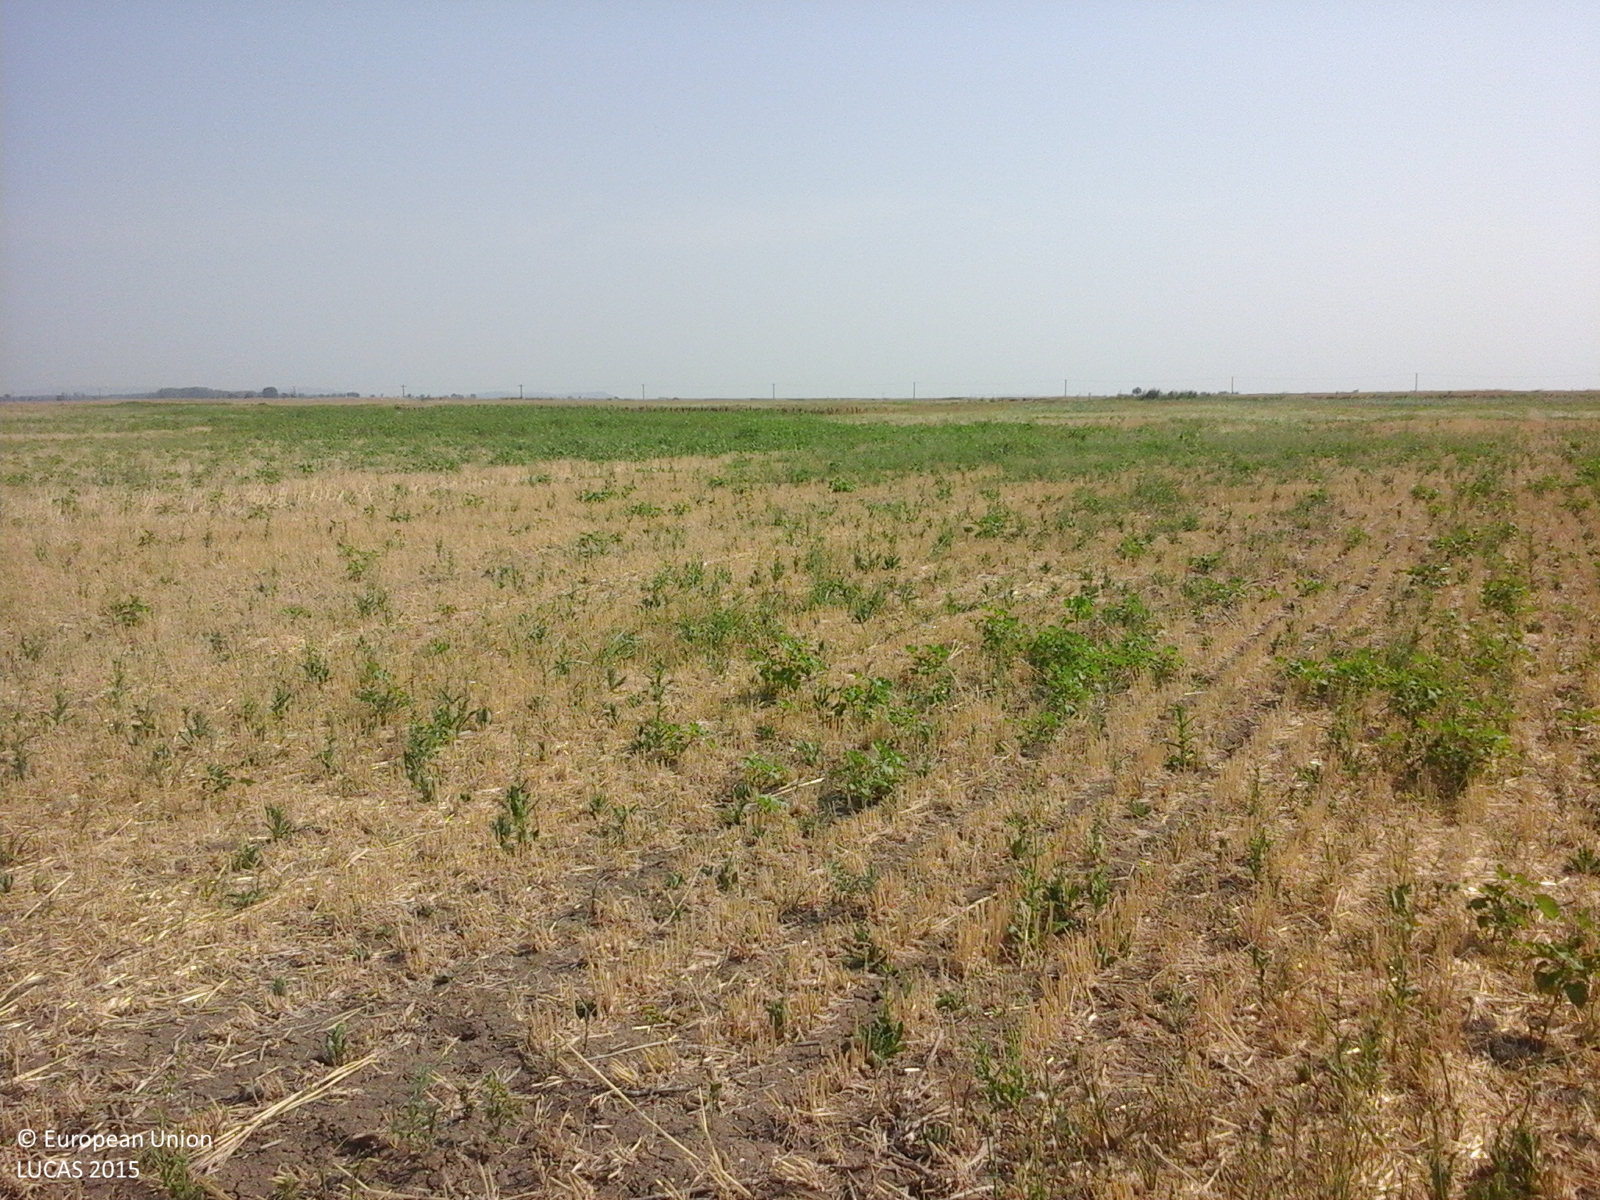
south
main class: Cropland
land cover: Rye
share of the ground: > 75 %
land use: Agriculture (excluding fallow land and kitchen gardens)
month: August
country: RO
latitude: 45.1604
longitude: 28.0927
